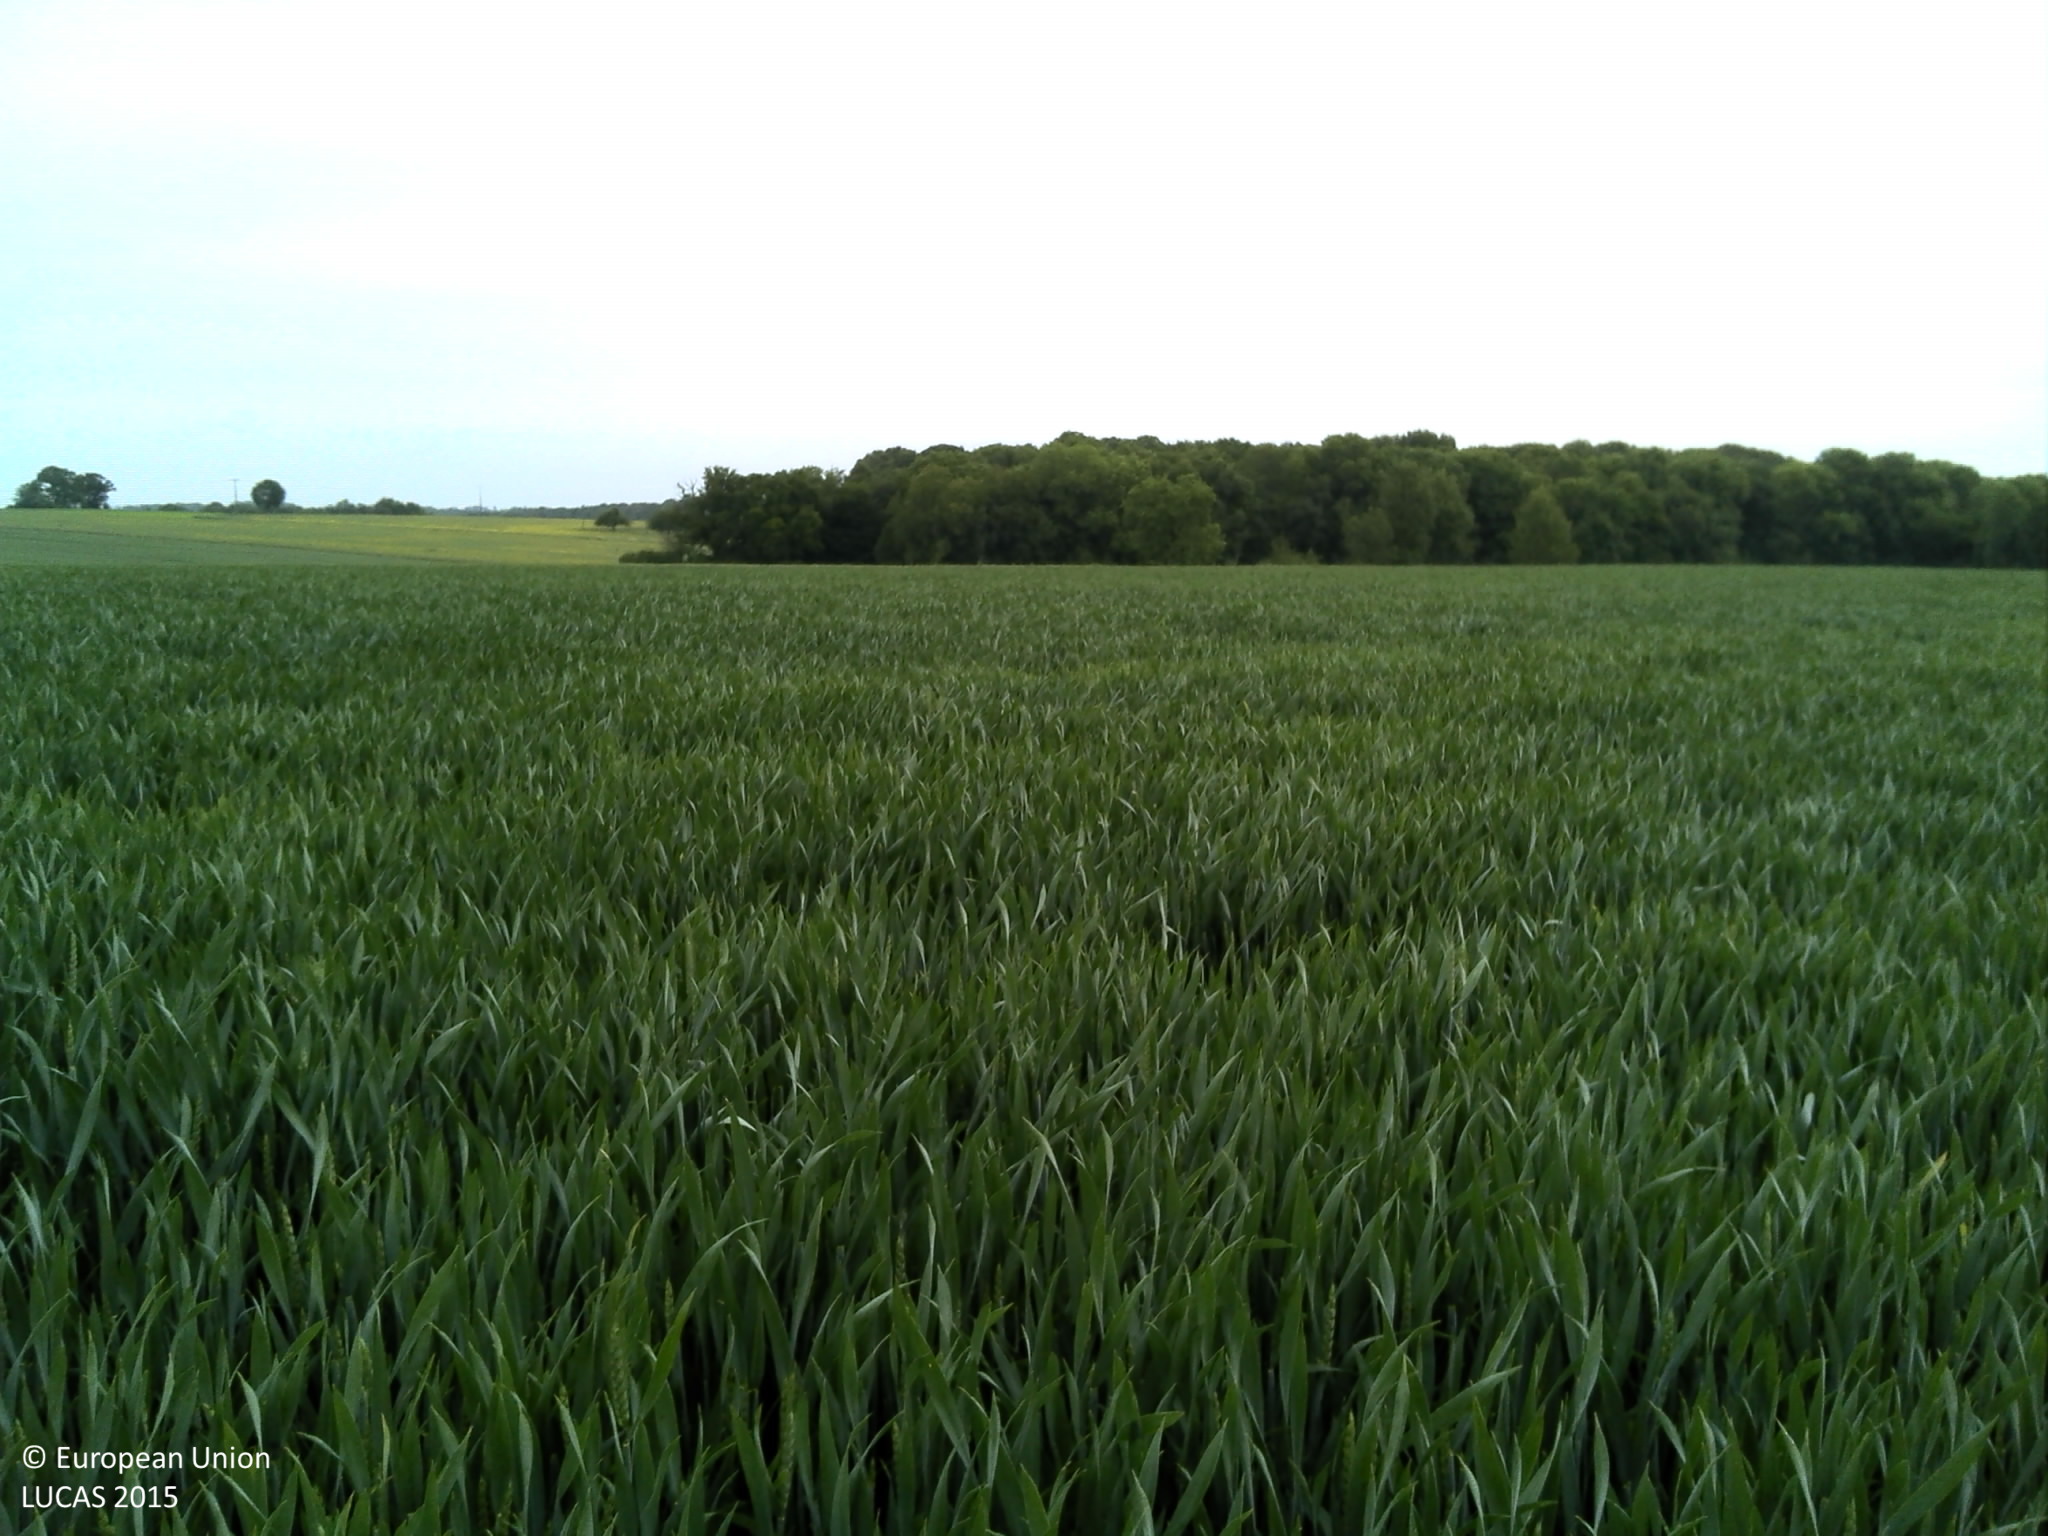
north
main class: Cropland
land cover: Durum wheat
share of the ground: > 75 %
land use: Agriculture (excluding fallow land and kitchen gardens)
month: May
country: FR
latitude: 49.3936
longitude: 1.2306
